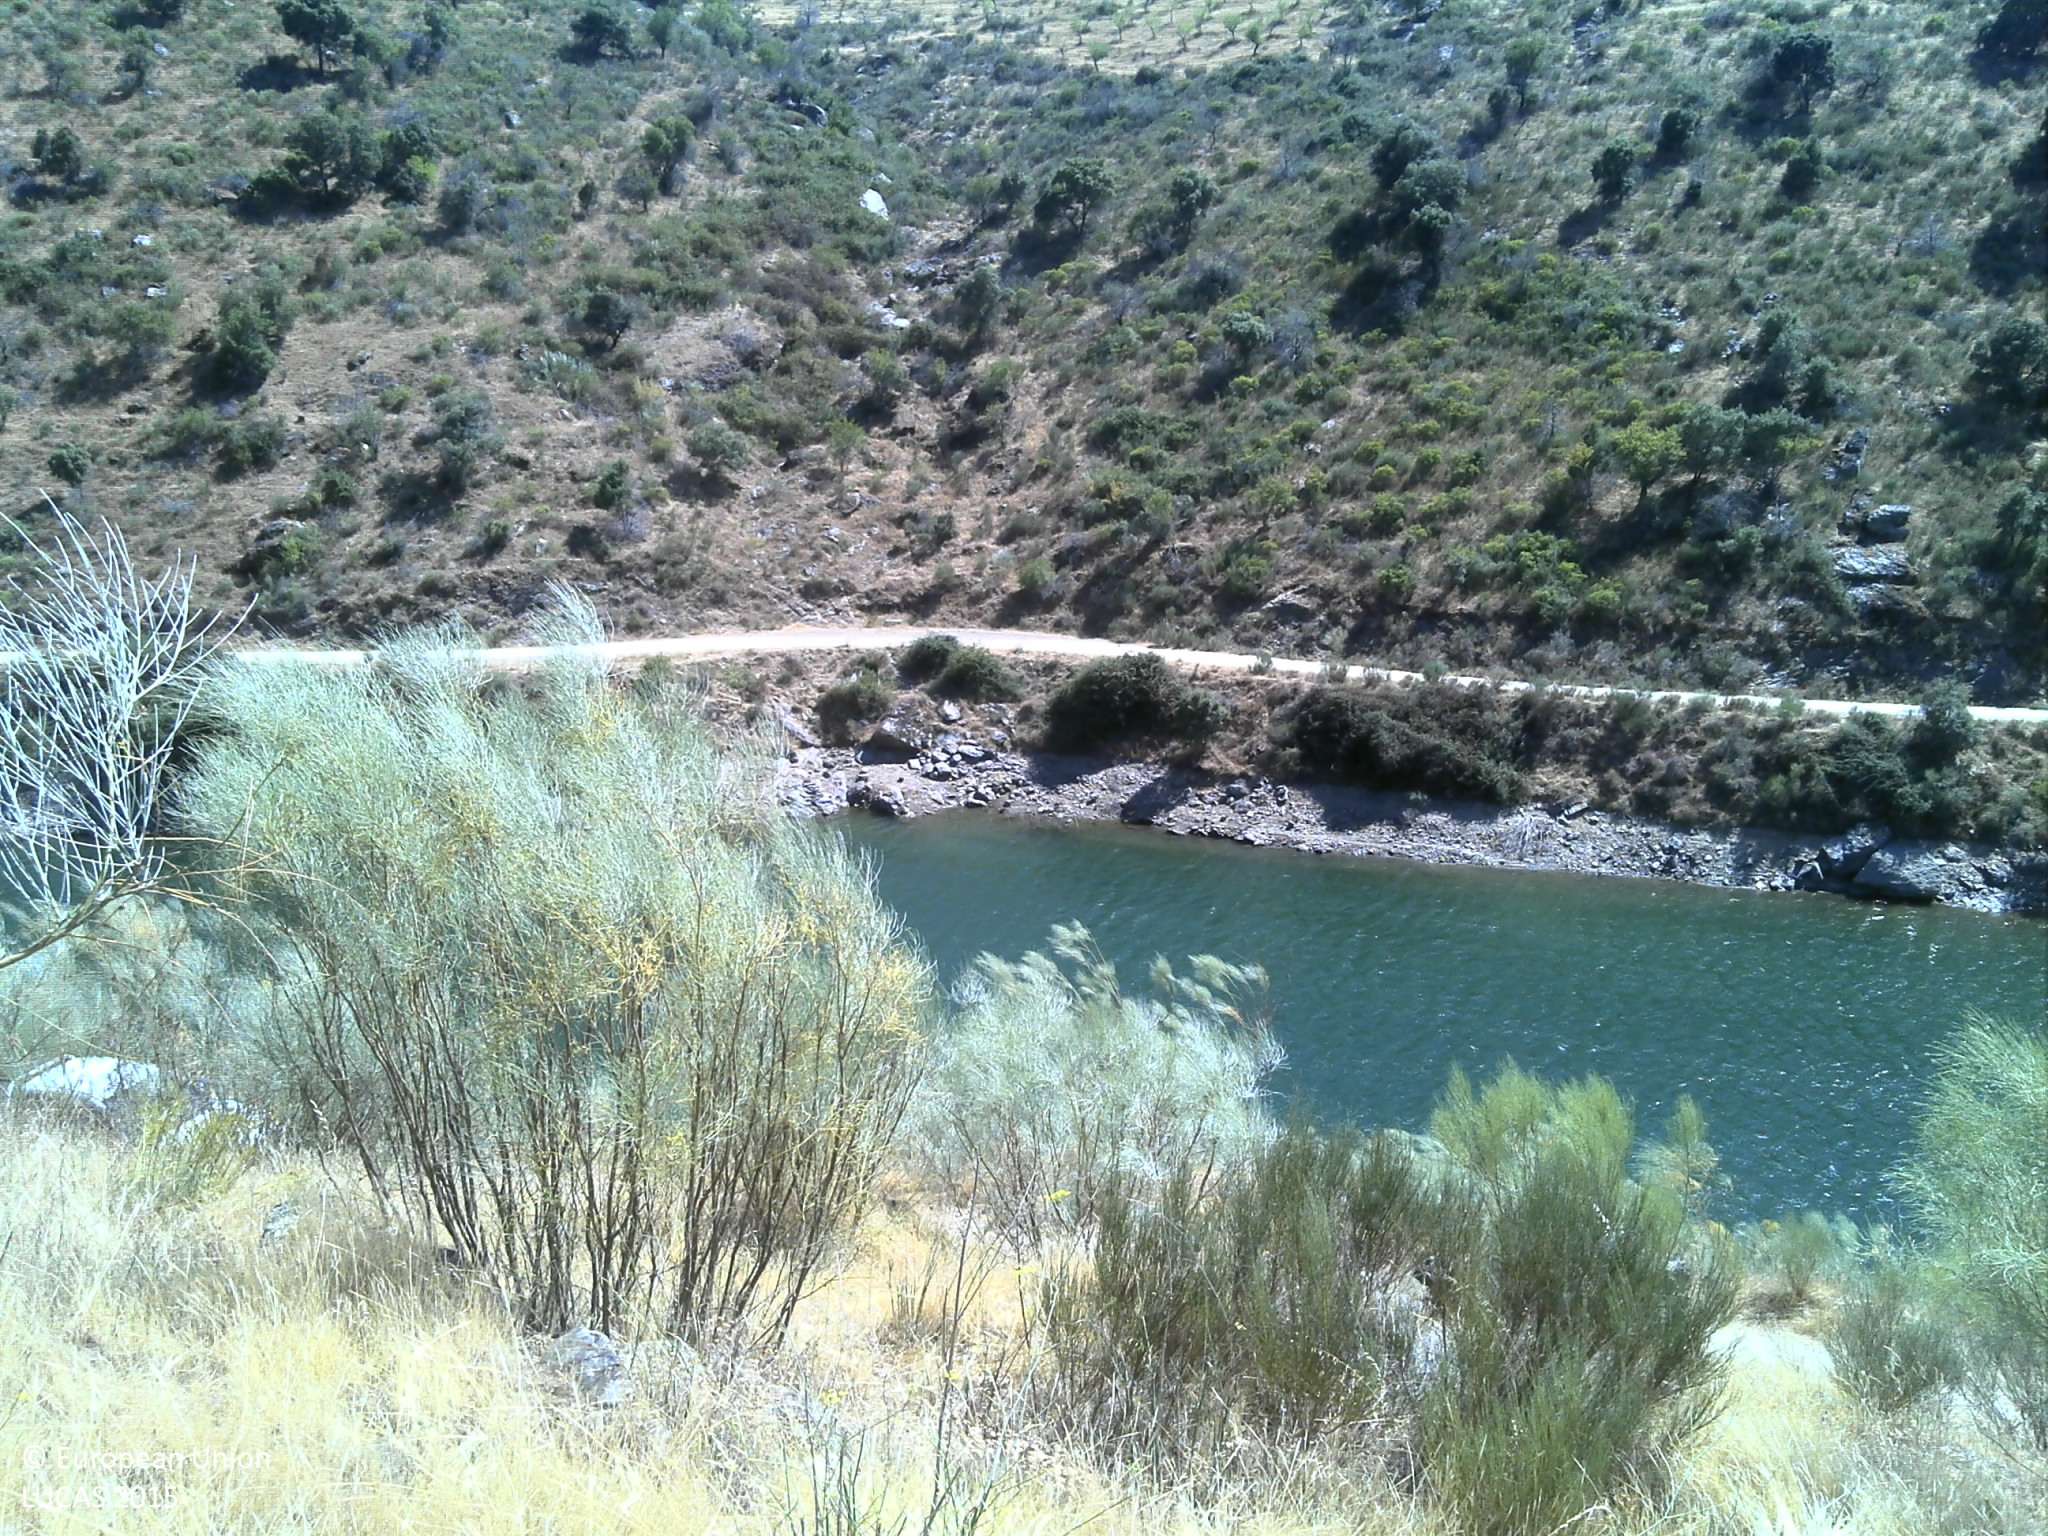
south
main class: Shrubland
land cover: Shrubland without tree cover
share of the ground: 25 - 50 %
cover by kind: herbaceous plants 55 %, shrubs 30 %, unconsolidated bare surface 10 %, consolidated bare surface 5 %
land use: Abandoned areas
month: July
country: PT
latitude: 41.3301
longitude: -7.0193
